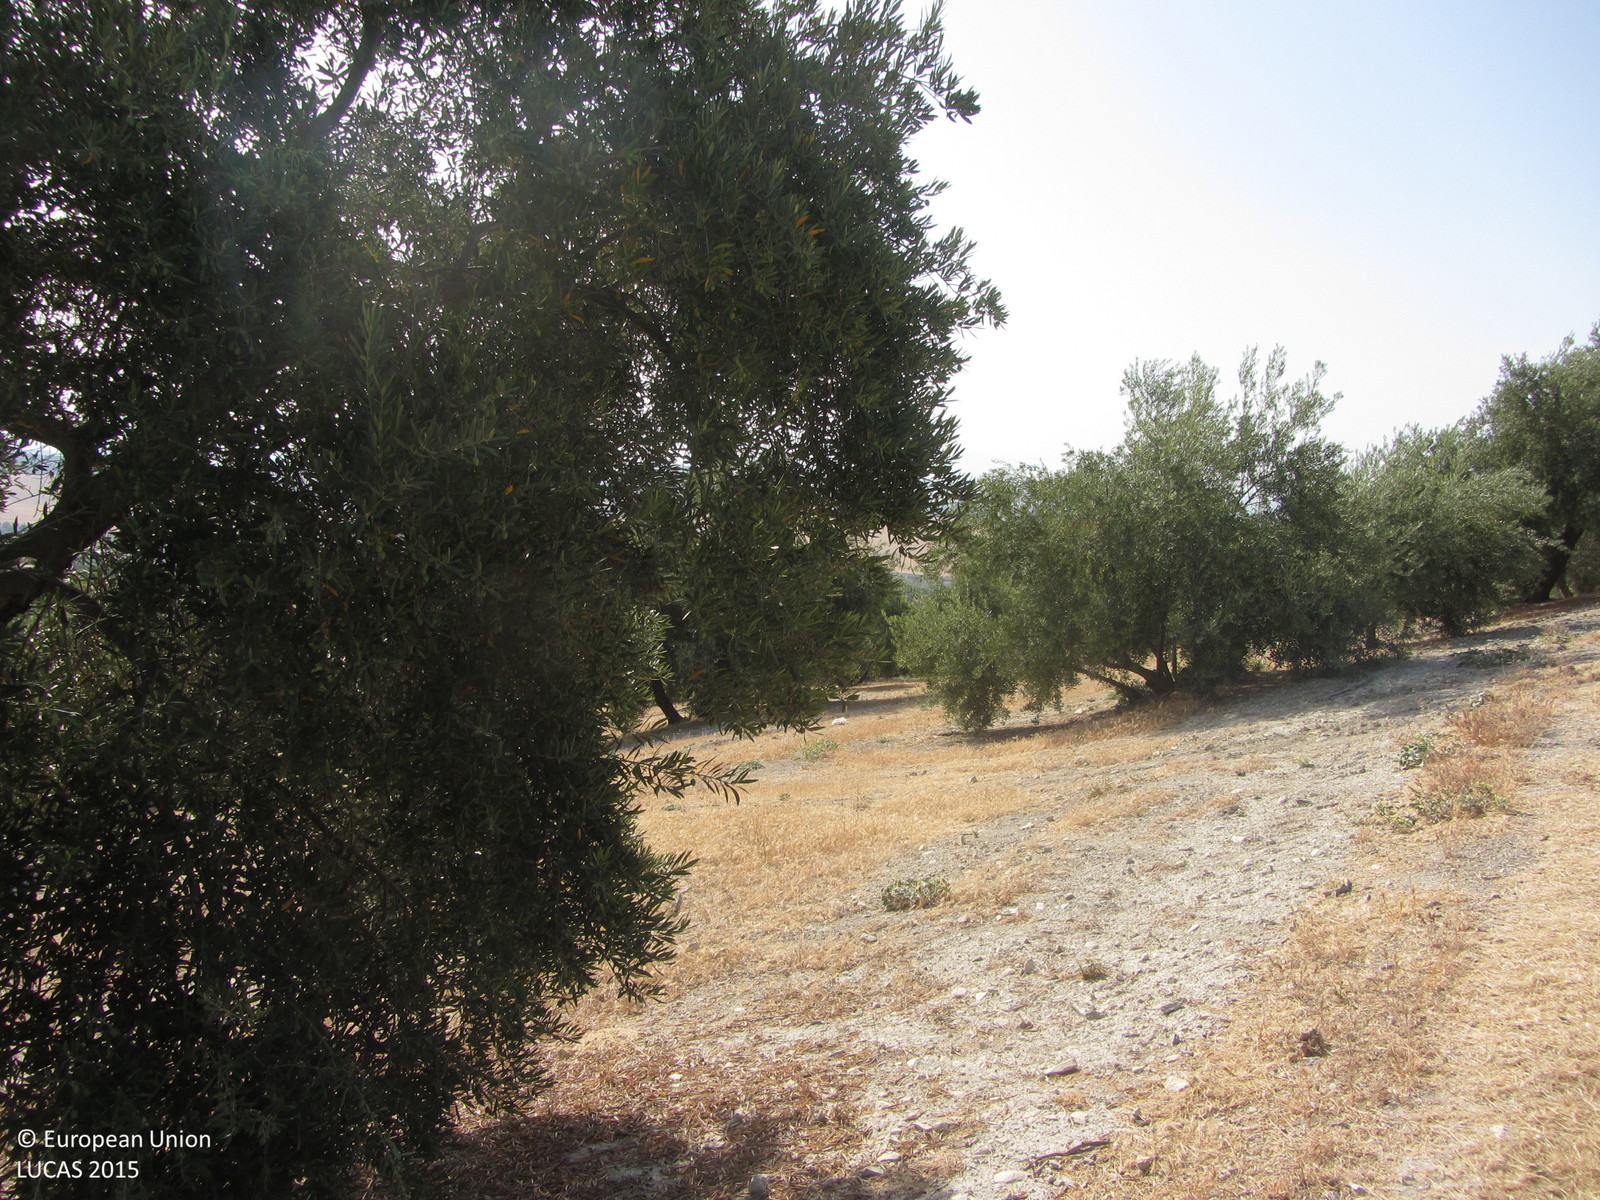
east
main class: Cropland
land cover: Olive groves
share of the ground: 25 - 50 %
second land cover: Spontaneously vegetated surfaces
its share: 10 - 25 %
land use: Agriculture (excluding fallow land and kitchen gardens)
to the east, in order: Olive groves; Spontaneously vegetated surfaces
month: July
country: ES
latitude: 37.9546
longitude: -3.3718
